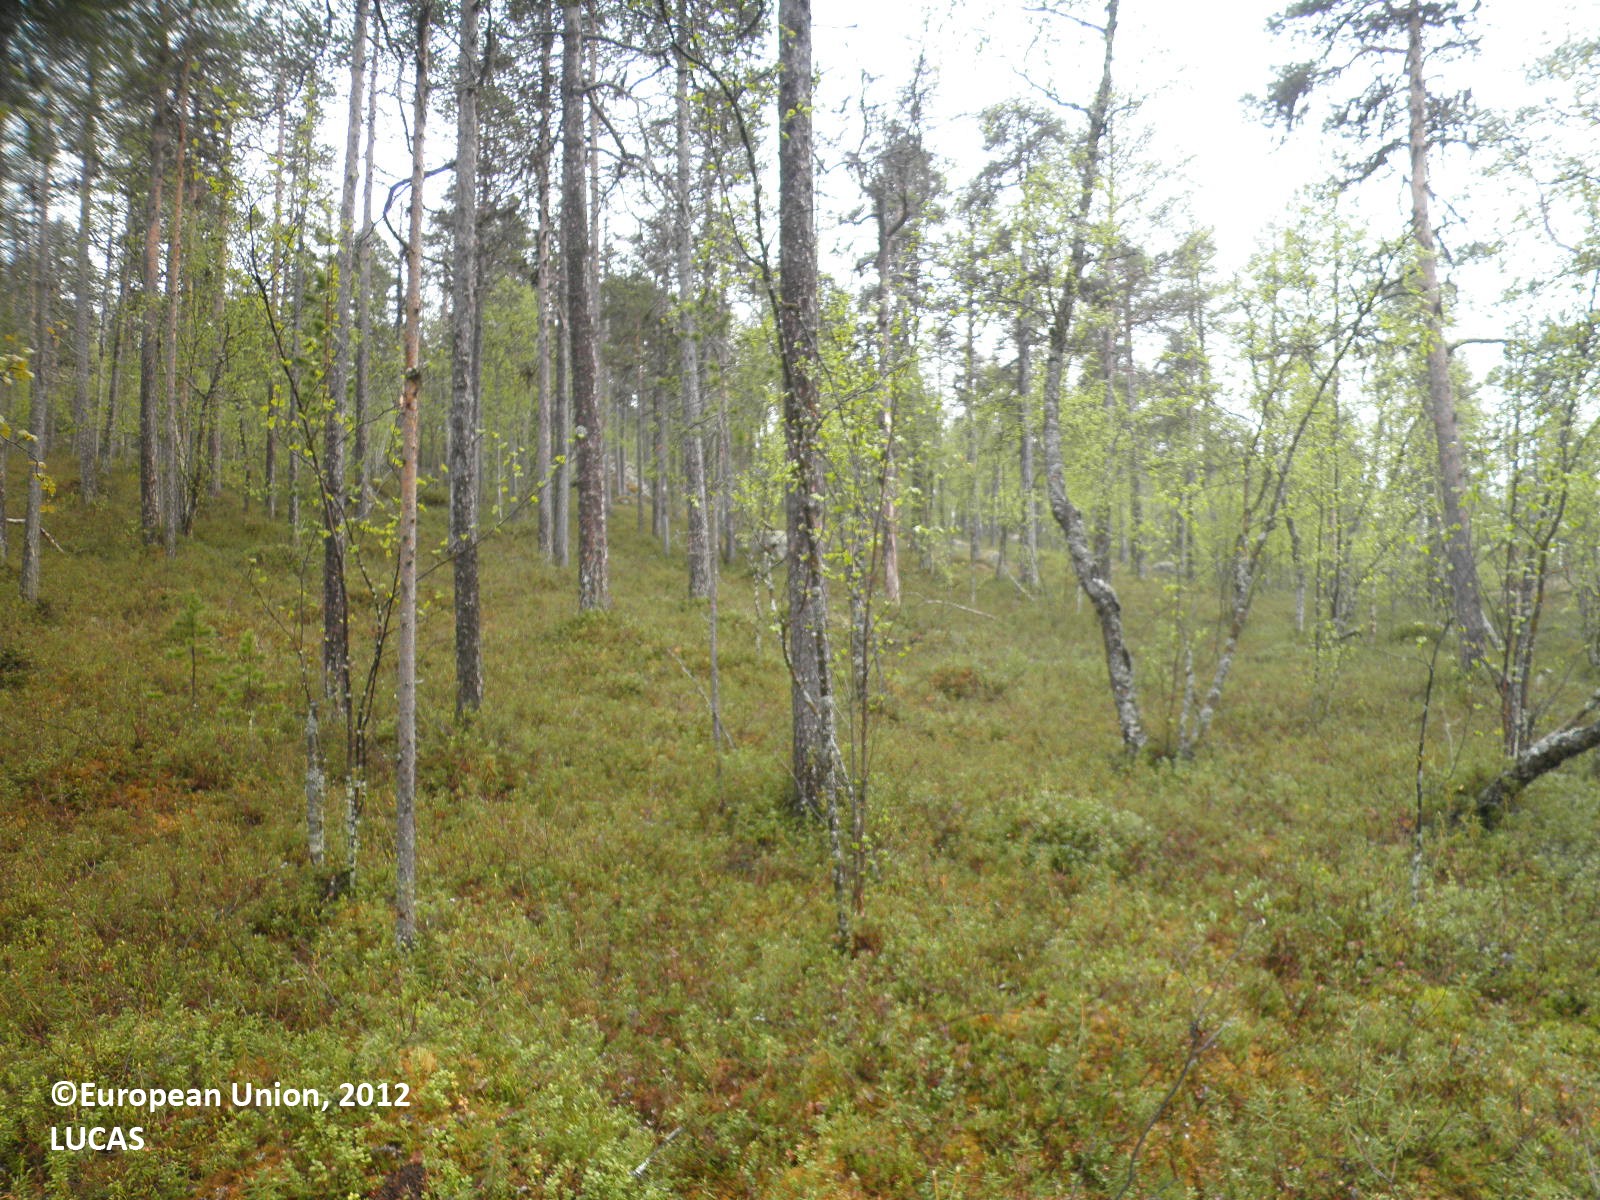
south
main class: Woodland
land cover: Pine dominated mixed woodland
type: boreal forest
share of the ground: > 75 %
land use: Forestry
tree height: > 5 m
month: June
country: FI
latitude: 69.0069
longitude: 26.9901
